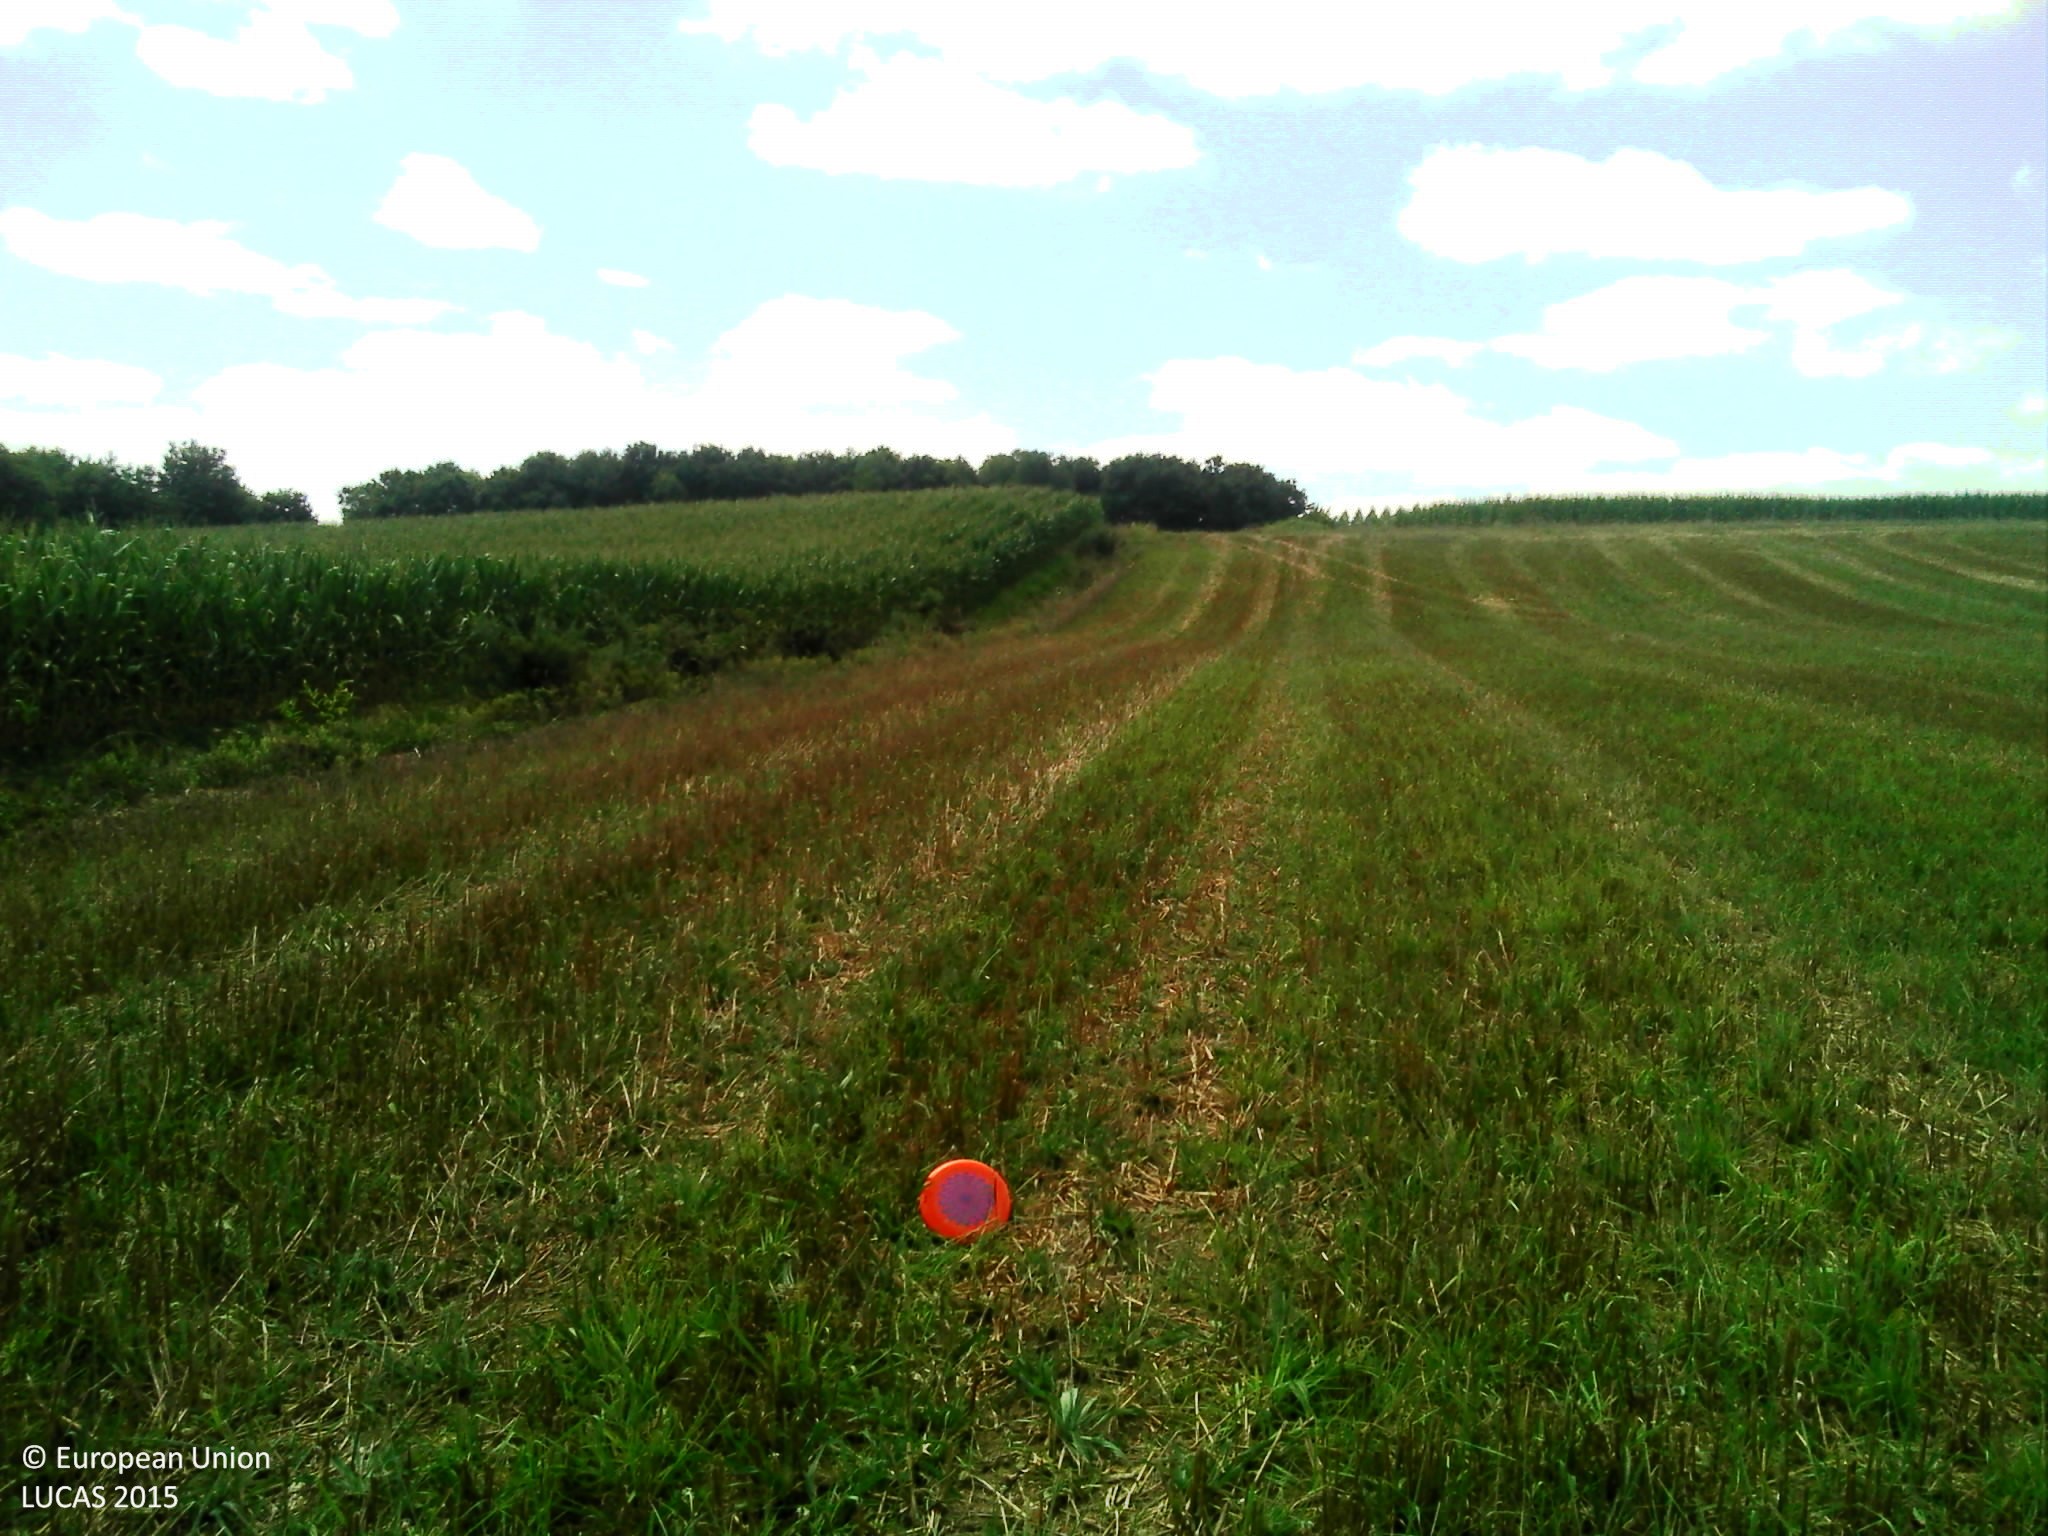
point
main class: Cropland
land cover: Temporary grasslands
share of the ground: > 75 %
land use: Agriculture (excluding fallow land and kitchen gardens)
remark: Harvested field
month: July
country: FR
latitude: 43.5181
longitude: -1.0868
